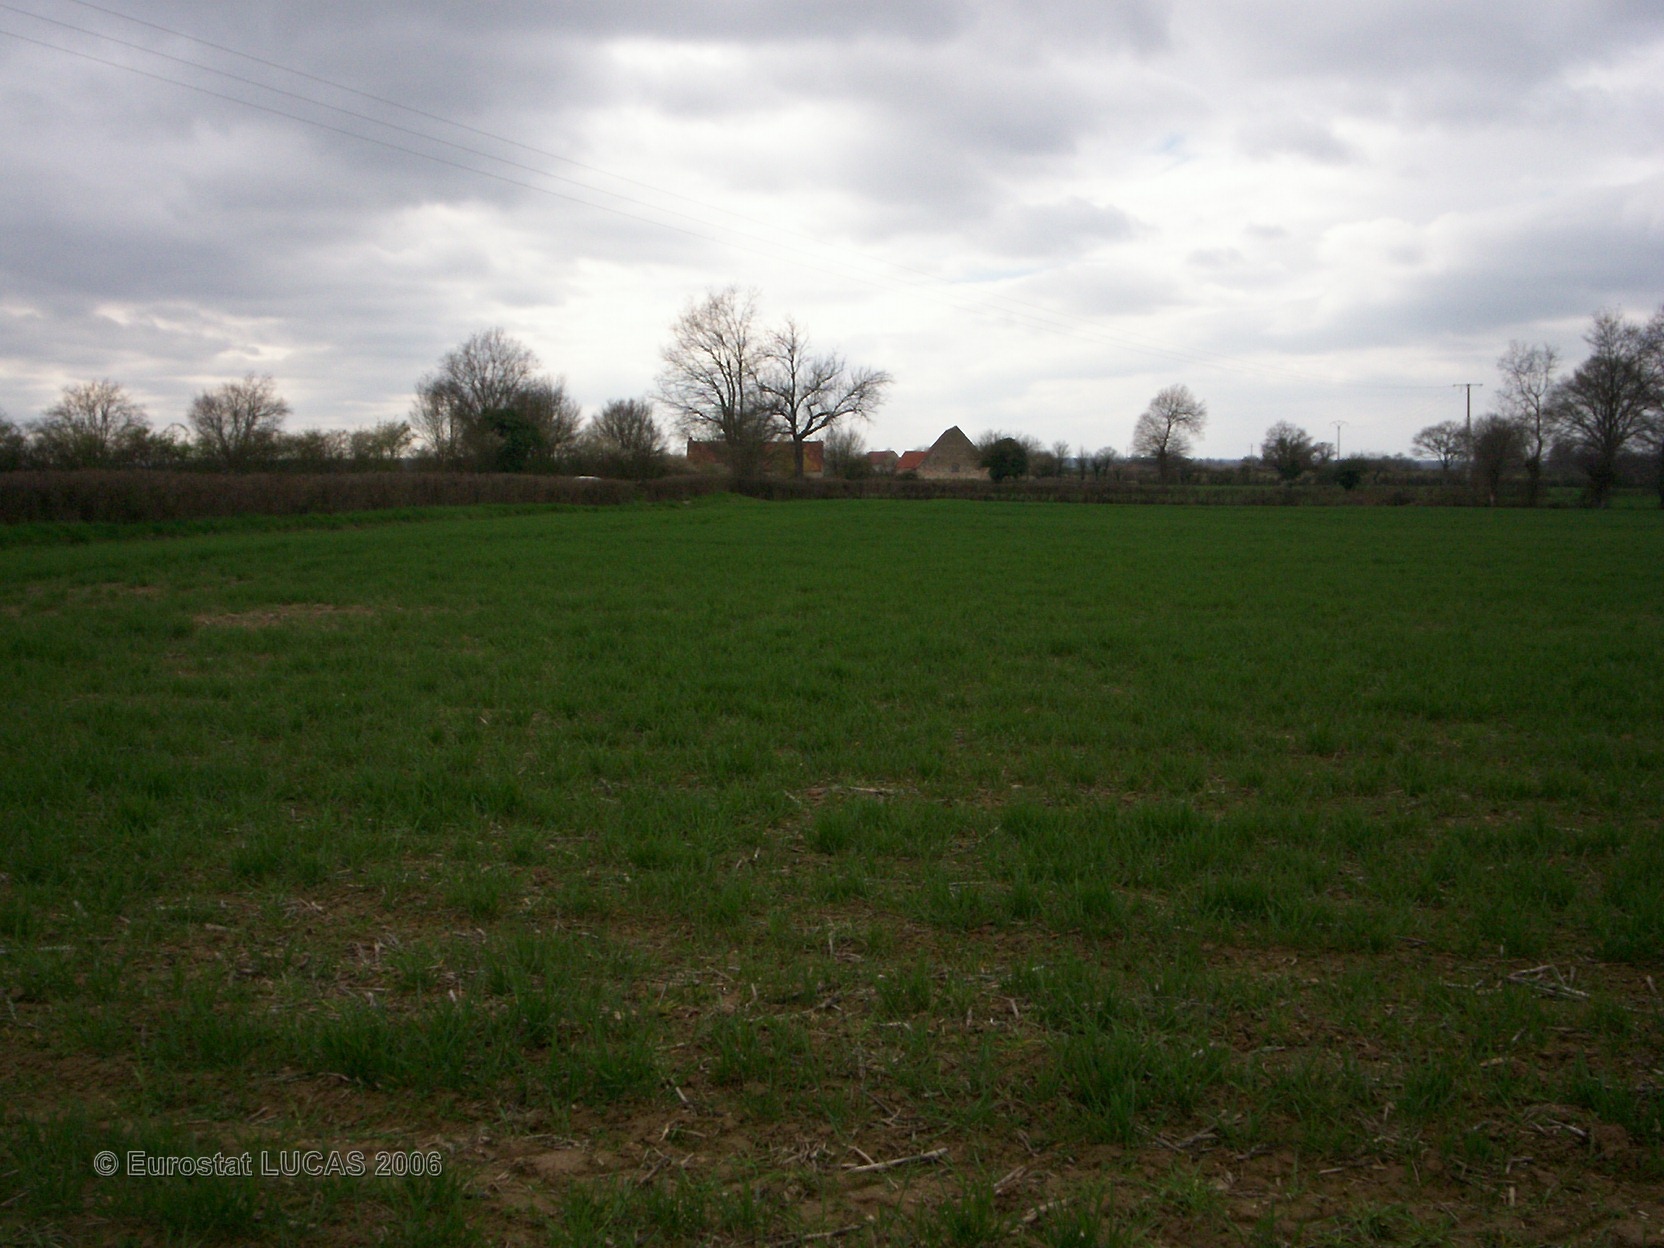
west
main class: Cropland
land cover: Common wheat
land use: Agriculture (excluding fallow land and kitchen gardens)
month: April
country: FR
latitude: 46.7214
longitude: 3.0494
